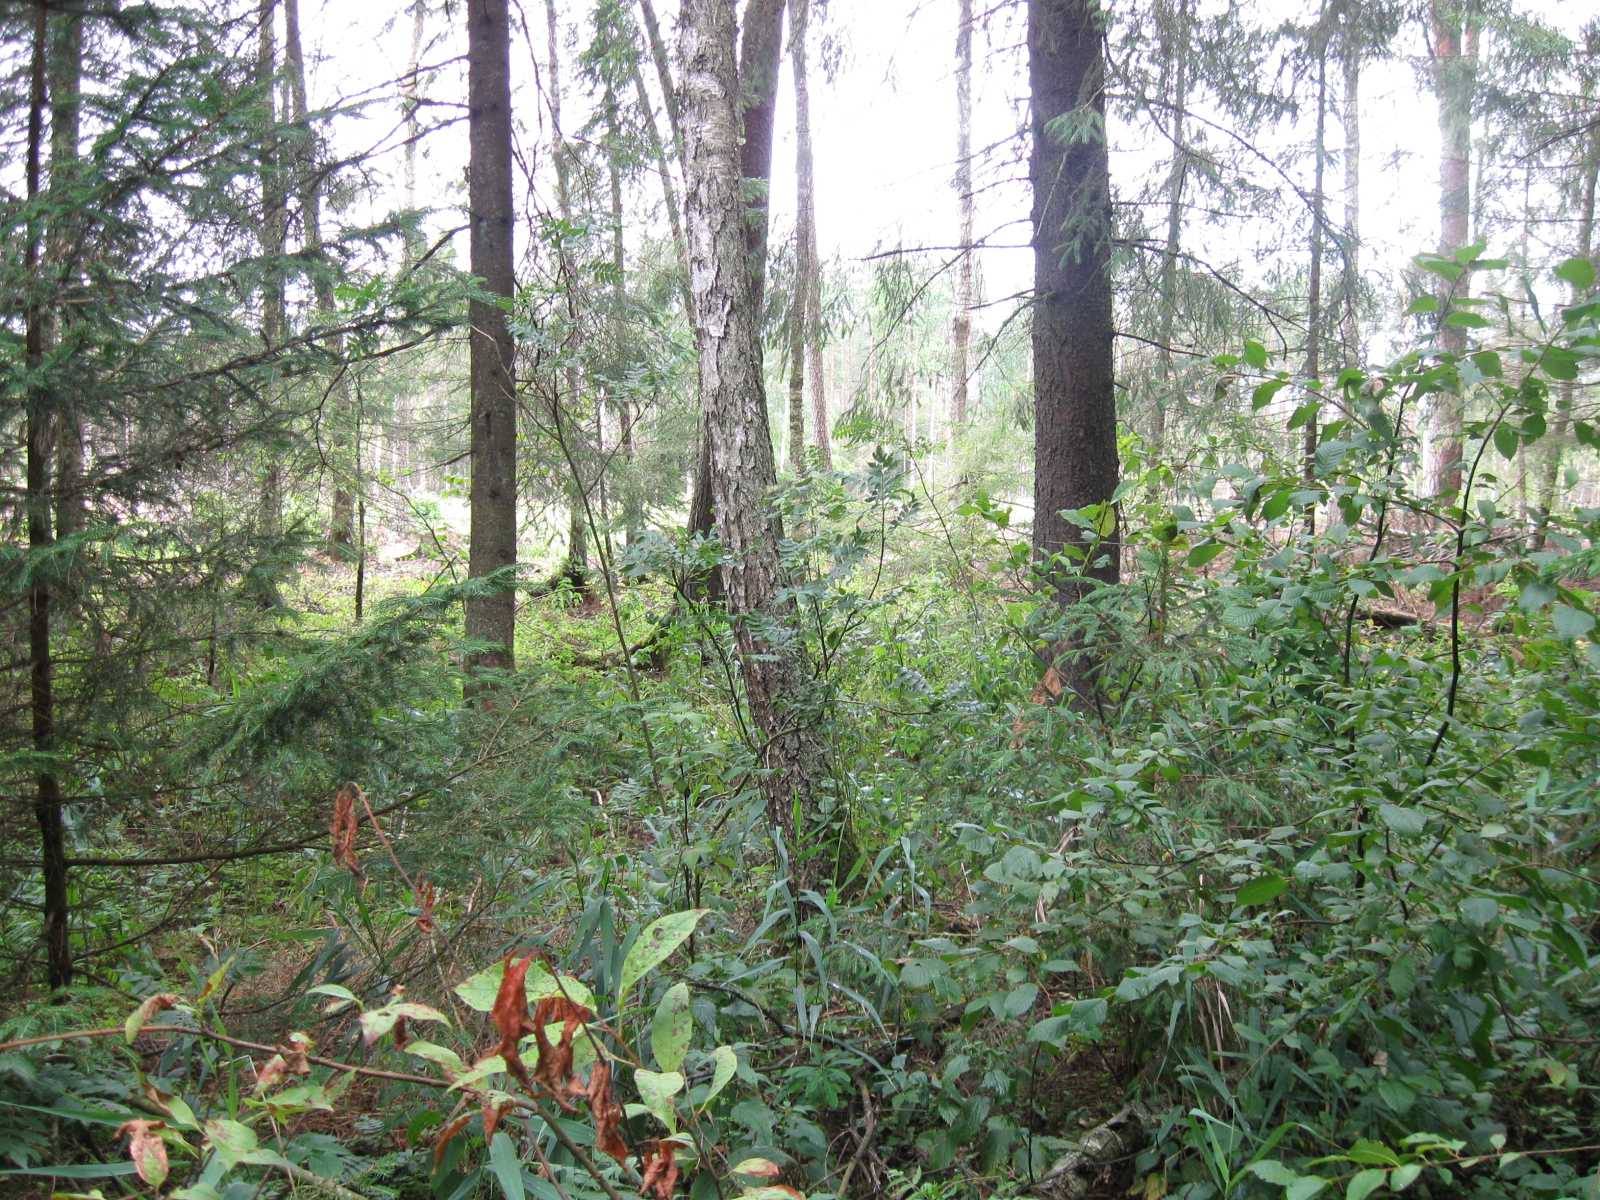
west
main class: Woodland
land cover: Other mixed woodland
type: mire and swamp forests
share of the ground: > 75 %
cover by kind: broadleaved forest trees 50 %, coniferous forest trees 35 %, shrubs 10 %, herbaceous plants 5 %
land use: Forestry
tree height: > 5 m
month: July
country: LT
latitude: 54.2969
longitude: 24.3435
